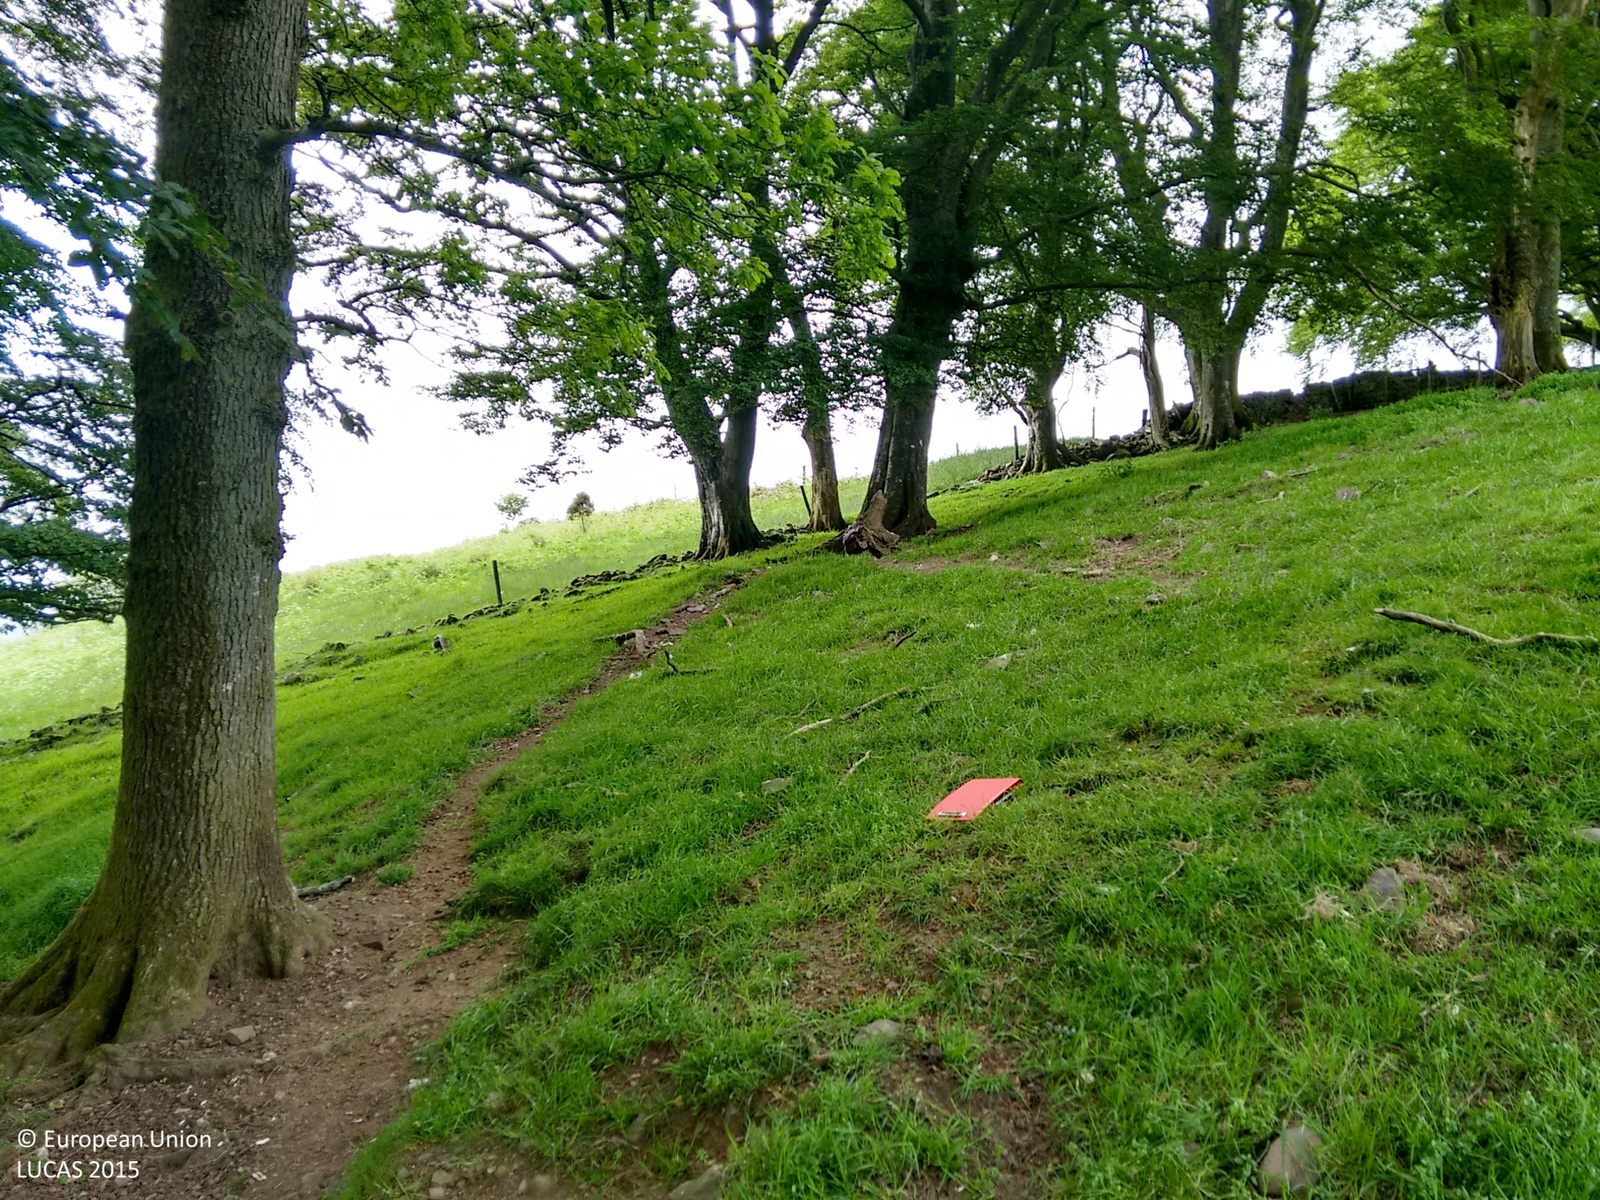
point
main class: Woodland
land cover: Broadleaved woodland
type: mesophytic deciduous forest
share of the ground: > 75 %
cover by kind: broadleaved forest trees 80 %, herbaceous plants 20 %
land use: Agriculture (excluding fallow land and kitchen gardens)
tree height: > 5 m
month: June
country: GB
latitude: 55.1921
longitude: -3.7031
